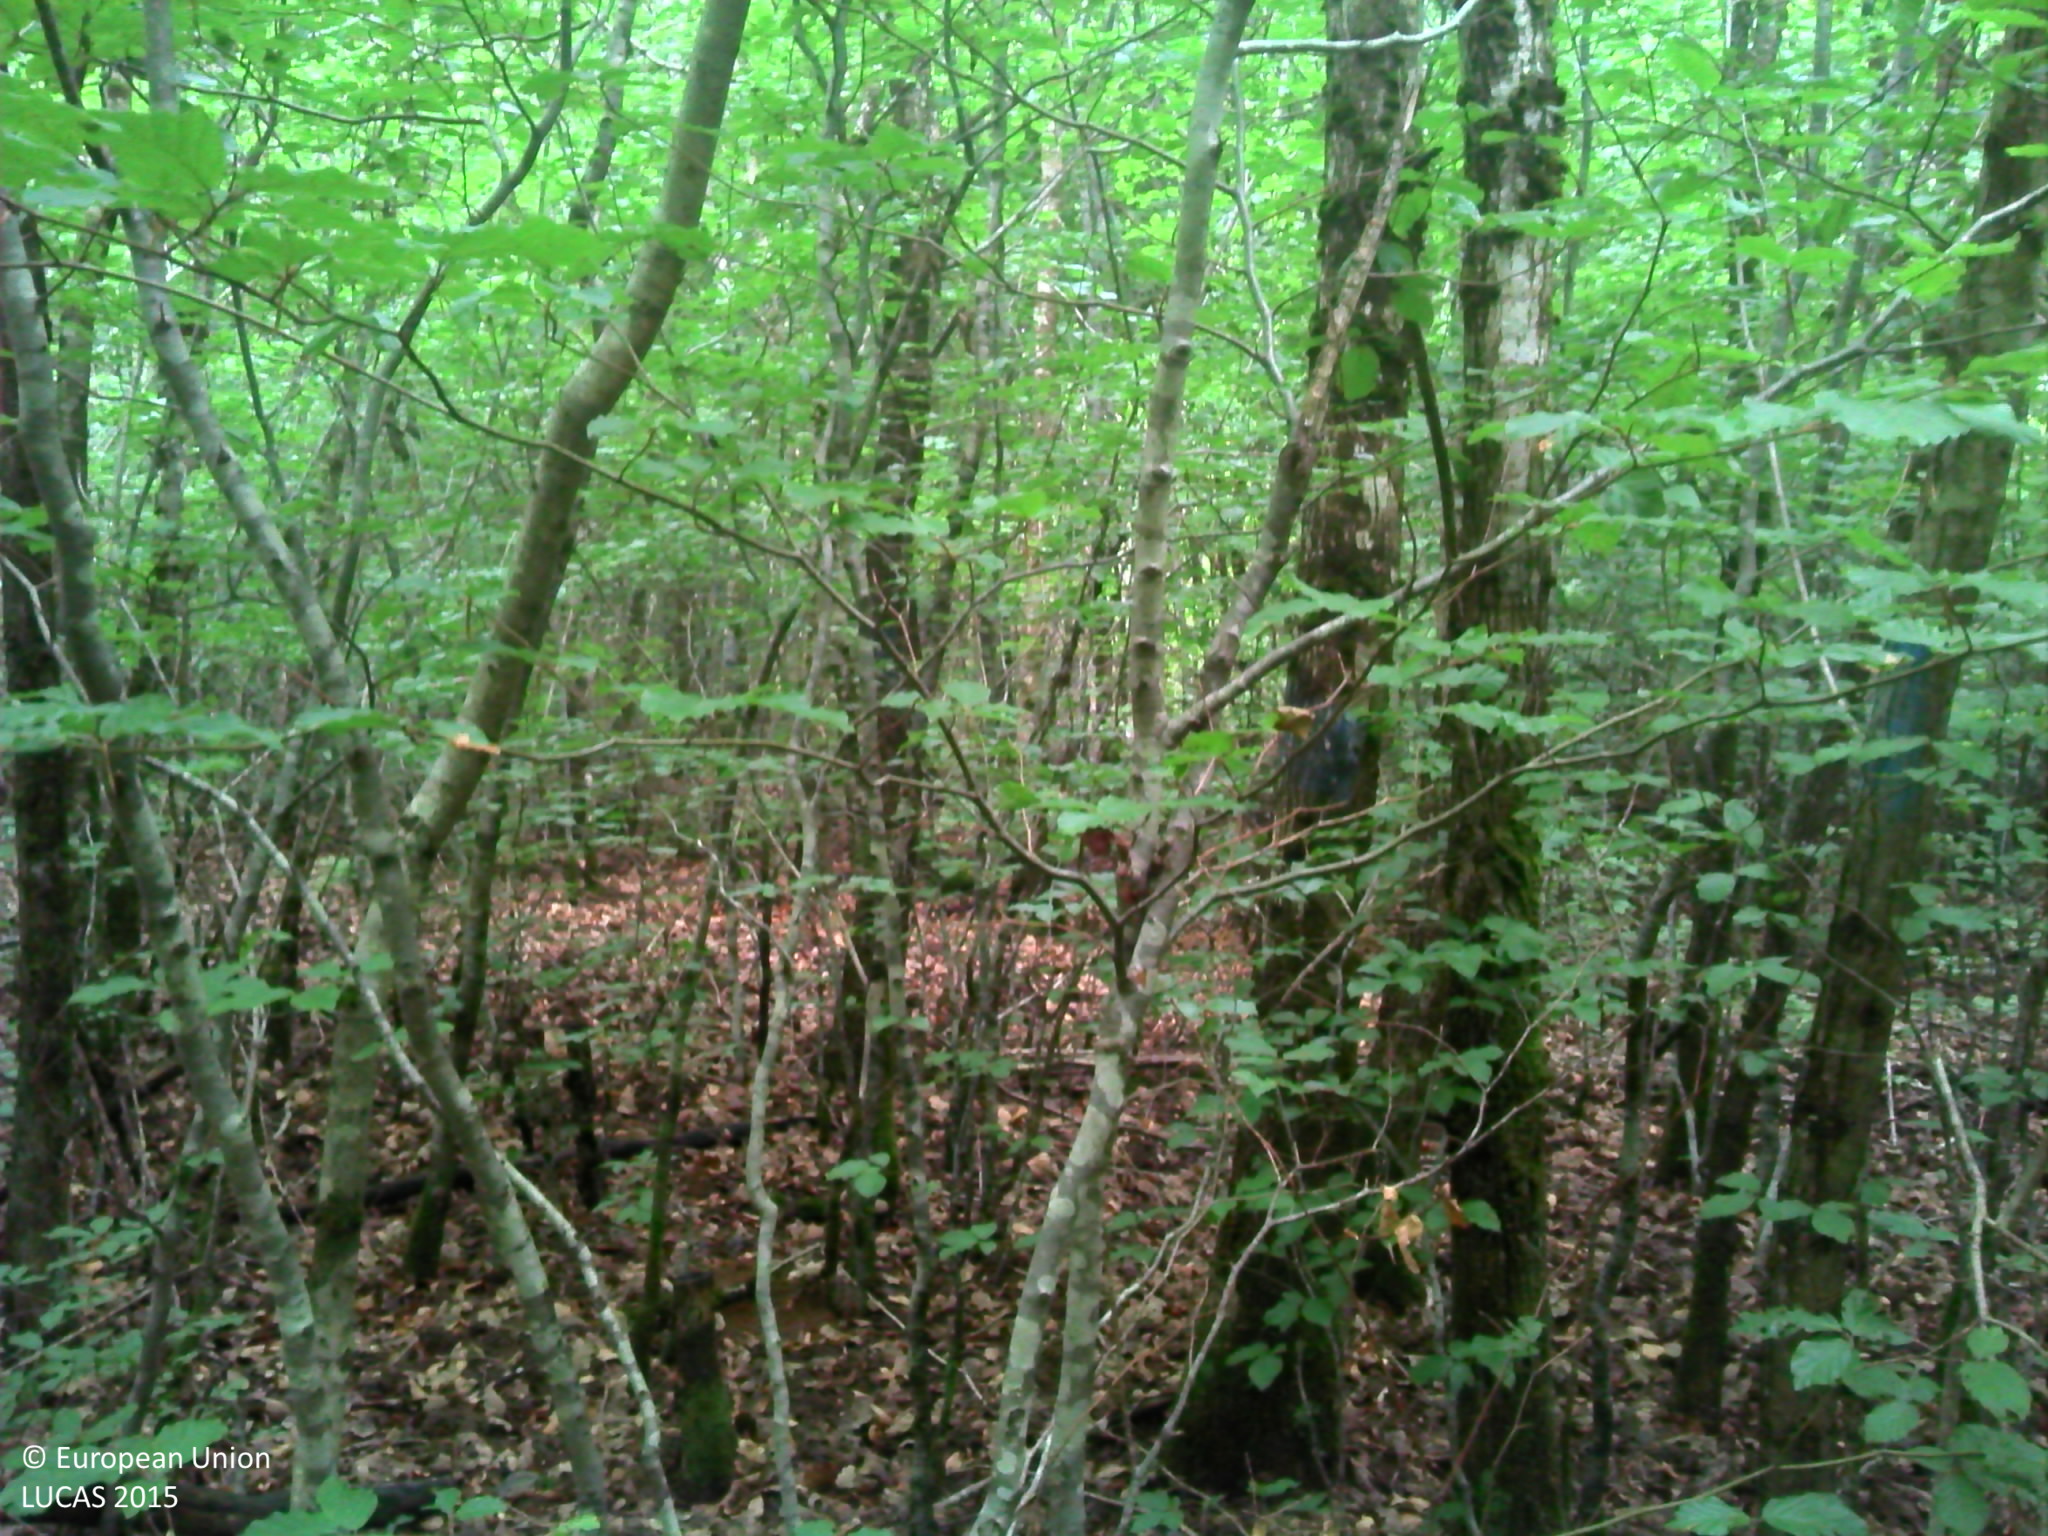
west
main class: Woodland
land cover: Broadleaved woodland
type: beech forest
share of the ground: > 75 %
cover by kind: broadleaved forest trees 90 %, unconsolidated bare surface 10 %
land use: Forestry
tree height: > 5 m
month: June
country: FR
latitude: 47.9109
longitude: 6.3483
